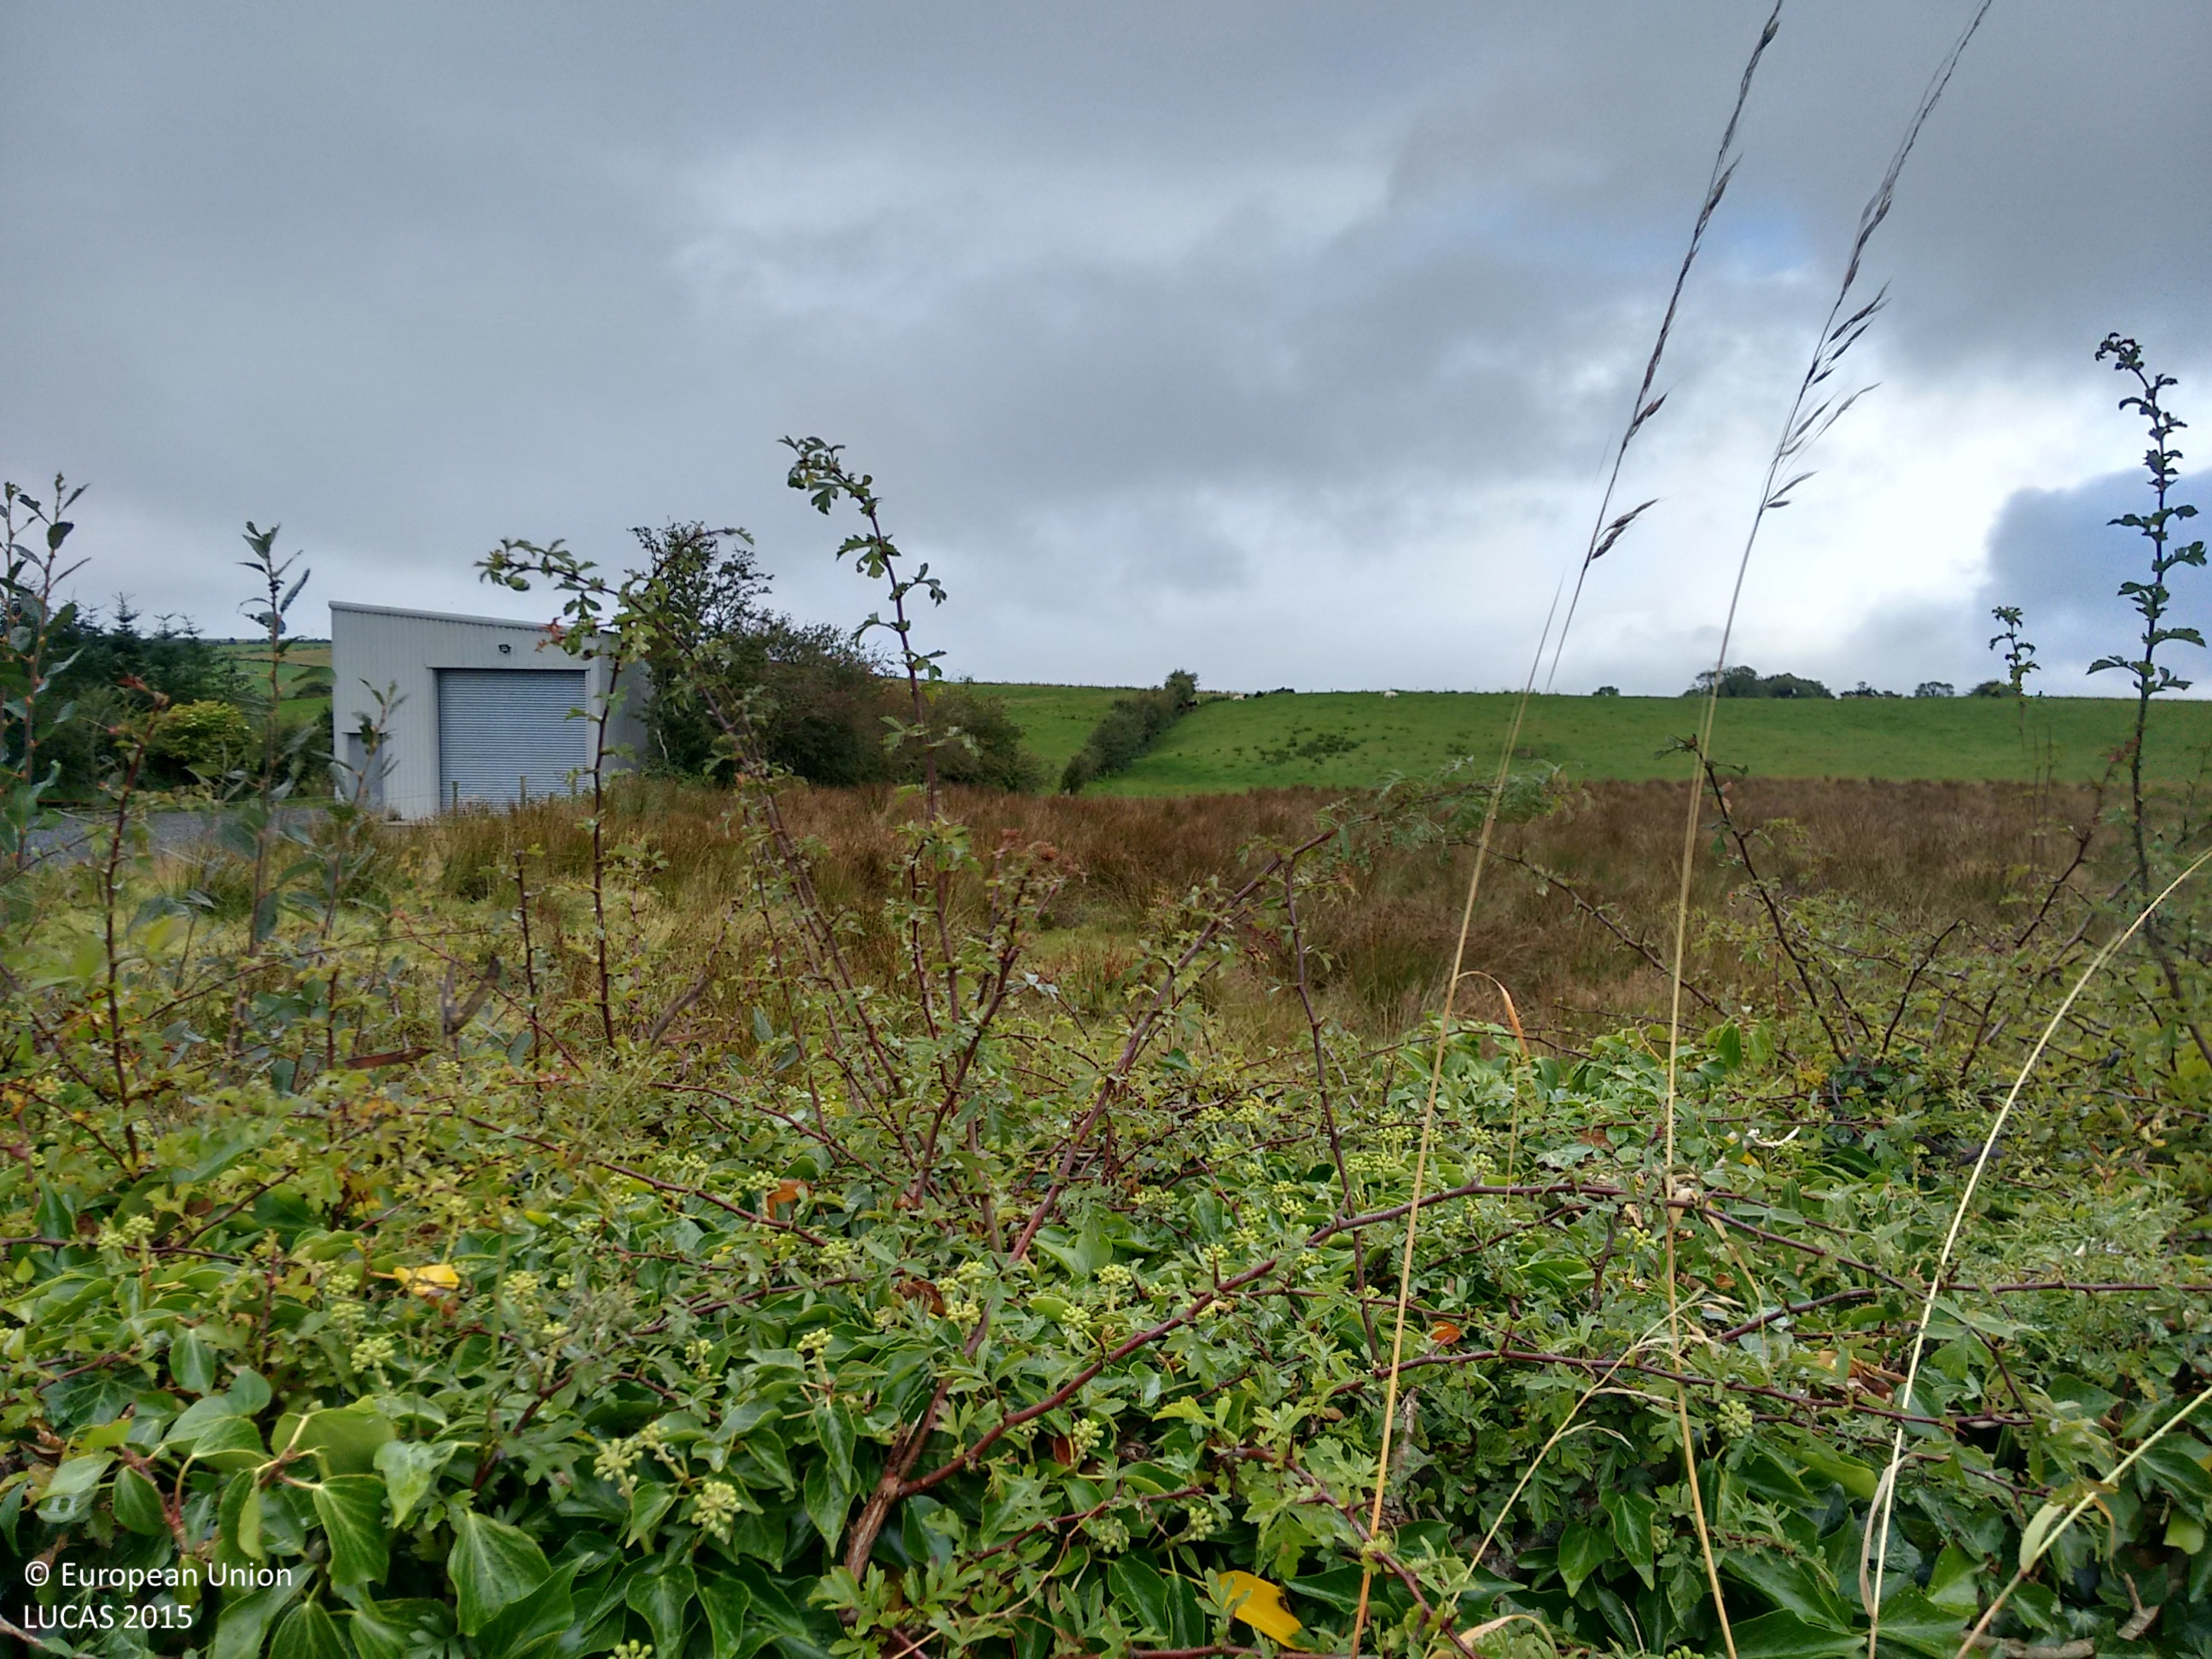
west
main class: Grassland
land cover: Grassland without tree/shrub cover
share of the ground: > 75 %
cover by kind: herbaceous plants 100 %
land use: Agriculture (excluding fallow land and kitchen gardens)
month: September
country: IE
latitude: 54.9604
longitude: -7.5702
